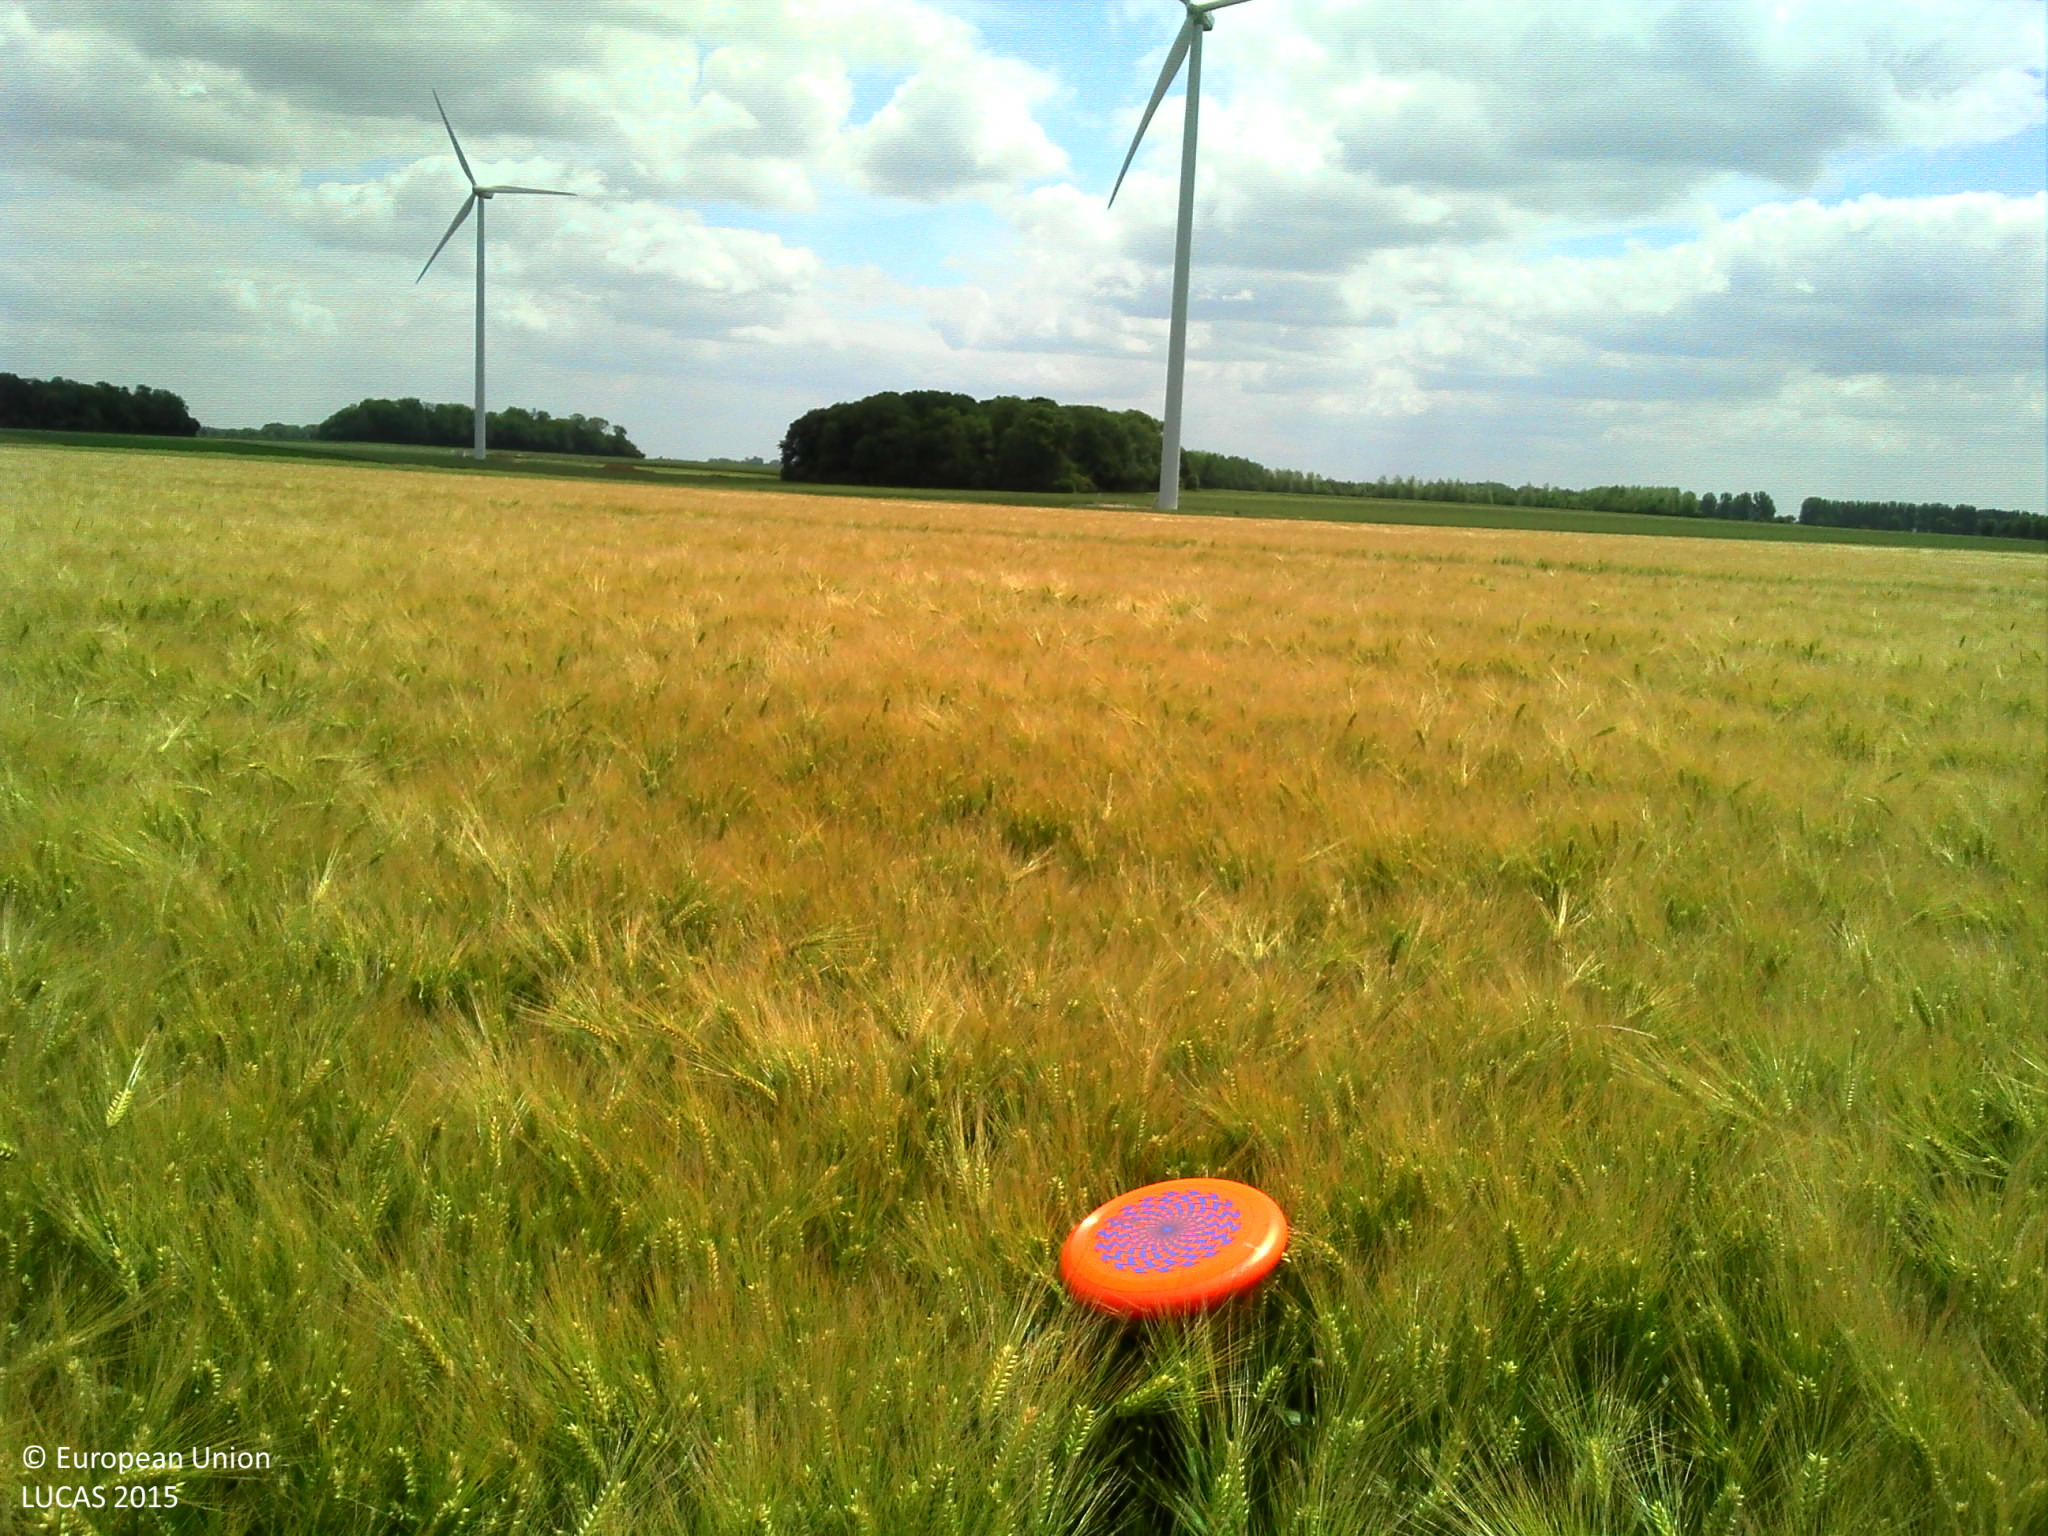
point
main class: Cropland
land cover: Barley
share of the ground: > 75 %
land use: Agriculture (excluding fallow land and kitchen gardens)
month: June
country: FR
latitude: 50.3861
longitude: 2.4627
